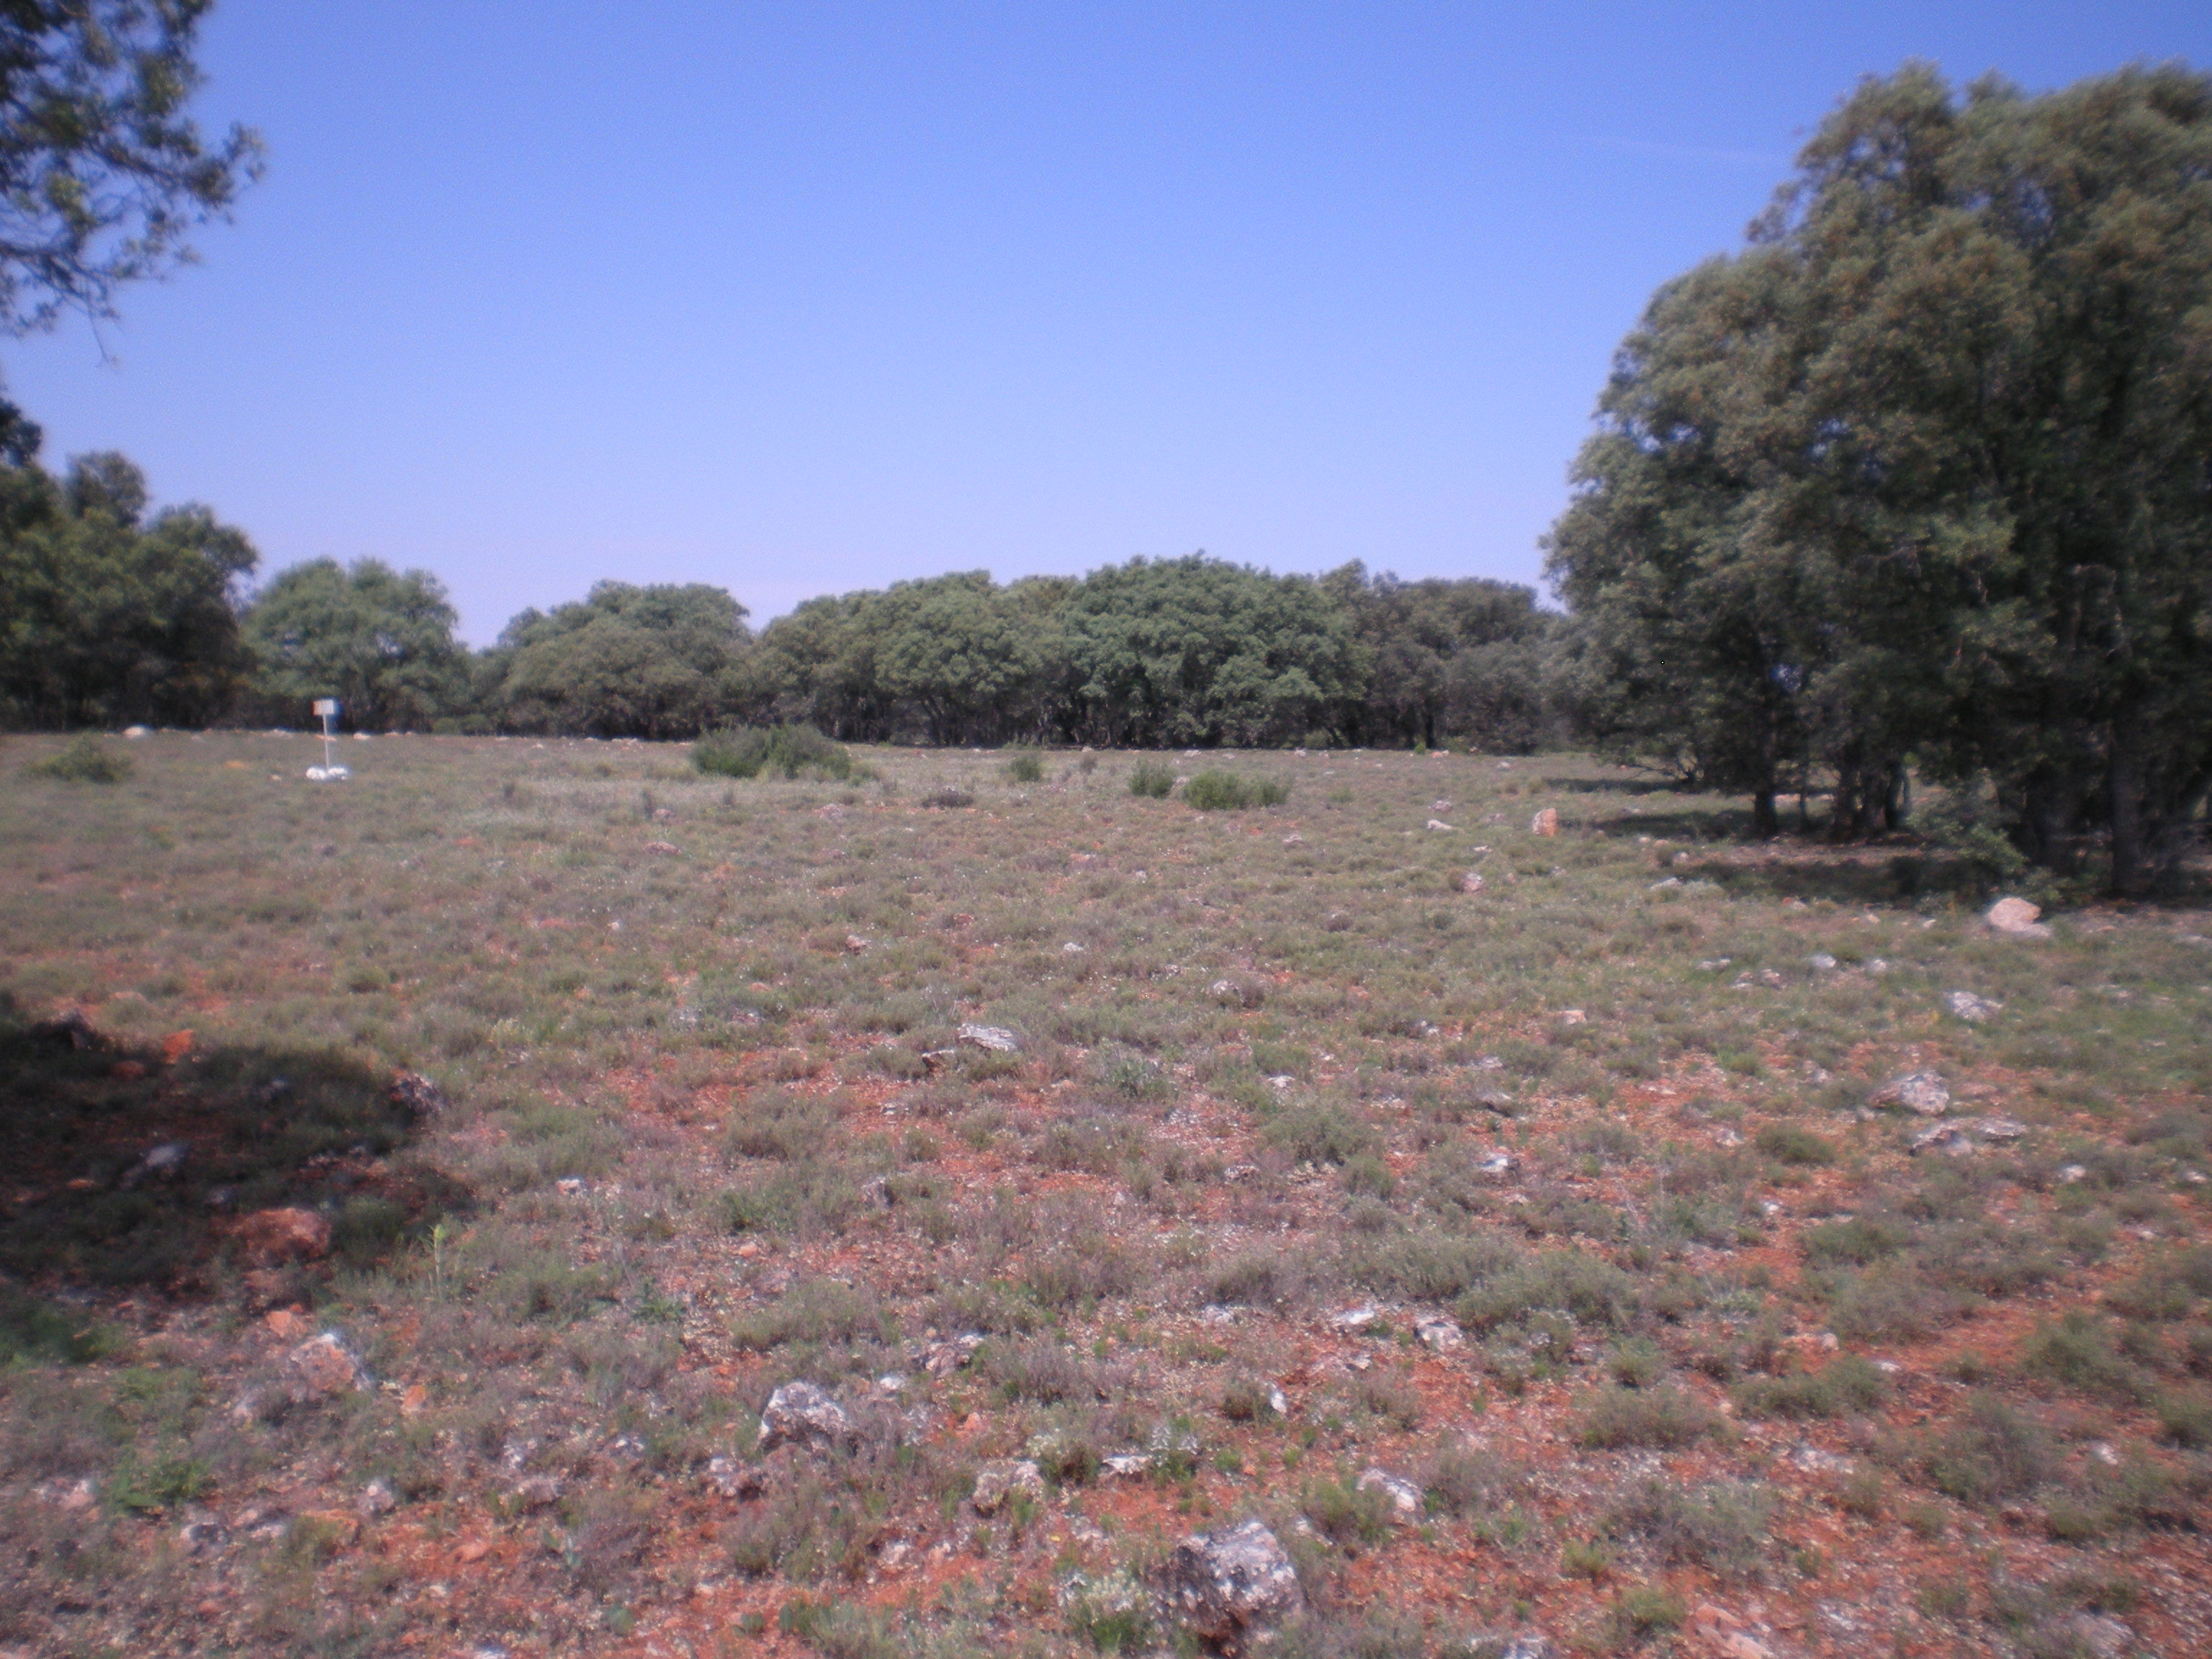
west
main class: Woodland
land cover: Broadleaved woodland
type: broadleaved evergreen forest
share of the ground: 25 - 50 %
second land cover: Shrubland without tree cover
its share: 25 - 50 %
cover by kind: unconsolidated bare surface 40 %, shrubs 35 %, broadleaved forest trees 15 %, herbaceous plants 10 %
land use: Forestry
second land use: Agriculture (excluding fallow land and kitchen gardens)
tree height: < 5 m
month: May
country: ES
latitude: 38.9126
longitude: -2.9365
